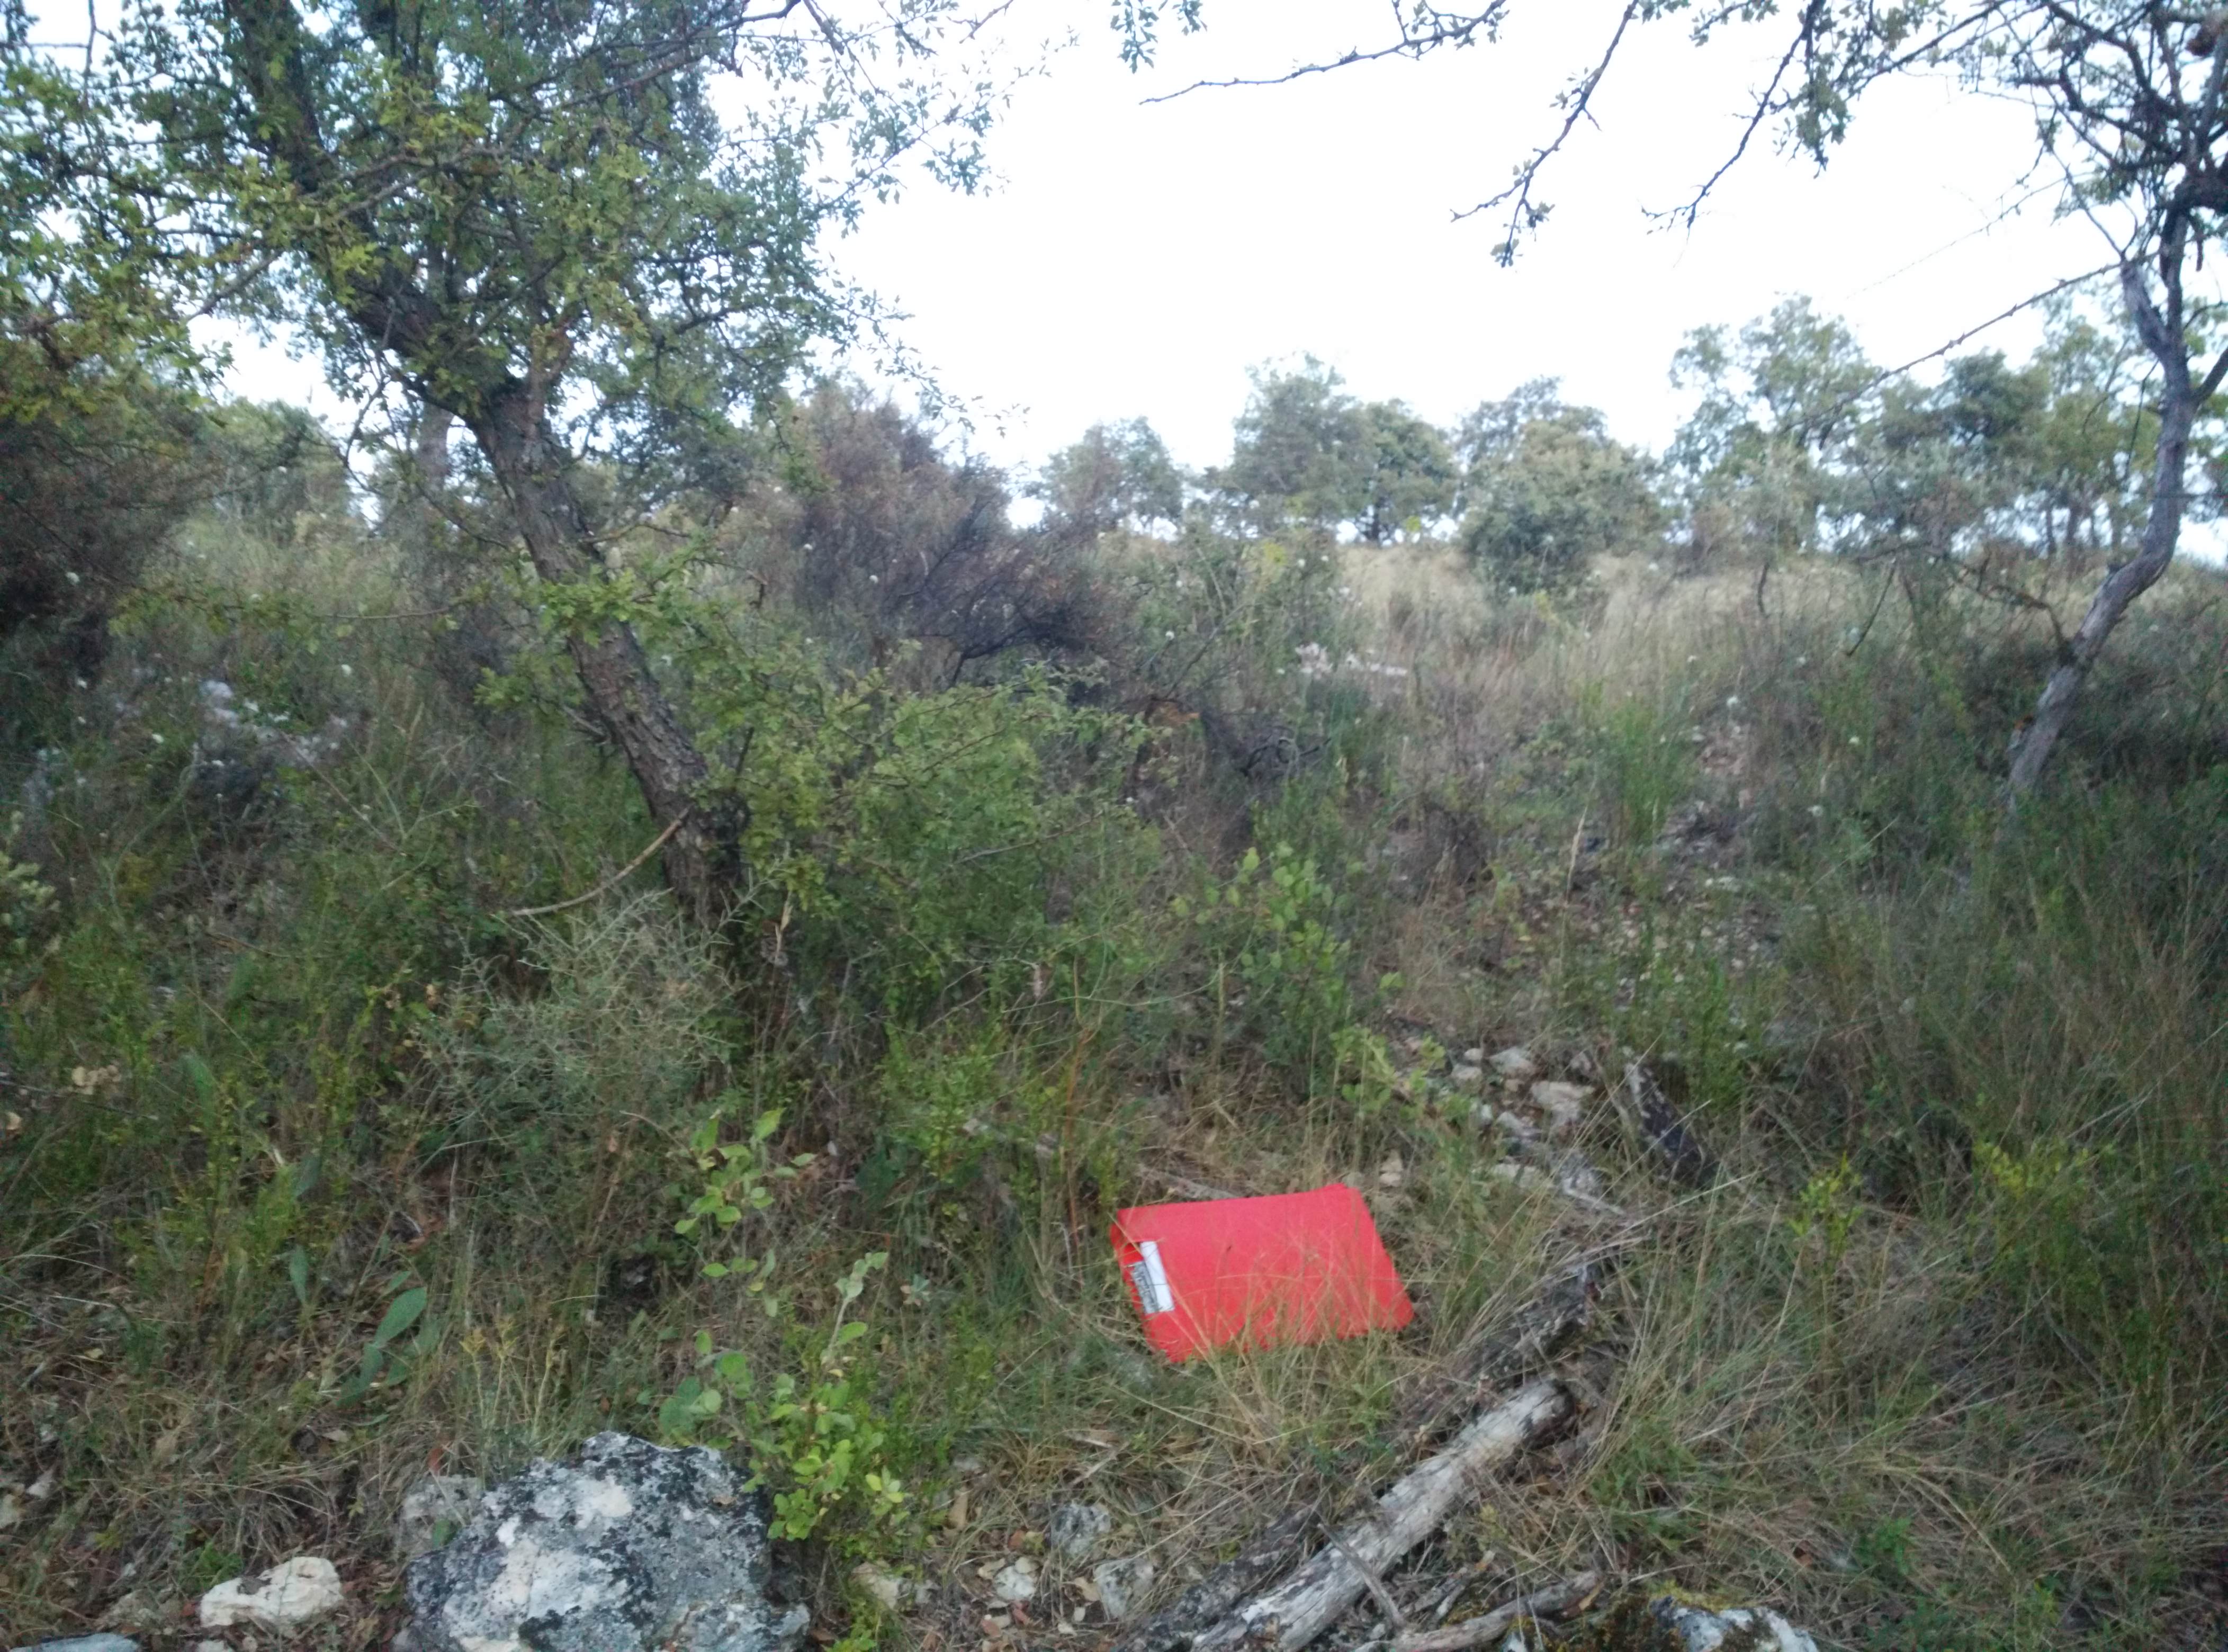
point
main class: Shrubland
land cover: Shrubland with sparse tree cover
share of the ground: 50 - 75 %
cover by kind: shrubs 60 %, unconsolidated bare surface 25 %, herbaceous plants 10 %, broadleaved forest trees 5 %
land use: Semi-natural and natural areas not in use
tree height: > 5 m
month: July
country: ES
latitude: 40.5567
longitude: -2.8184
